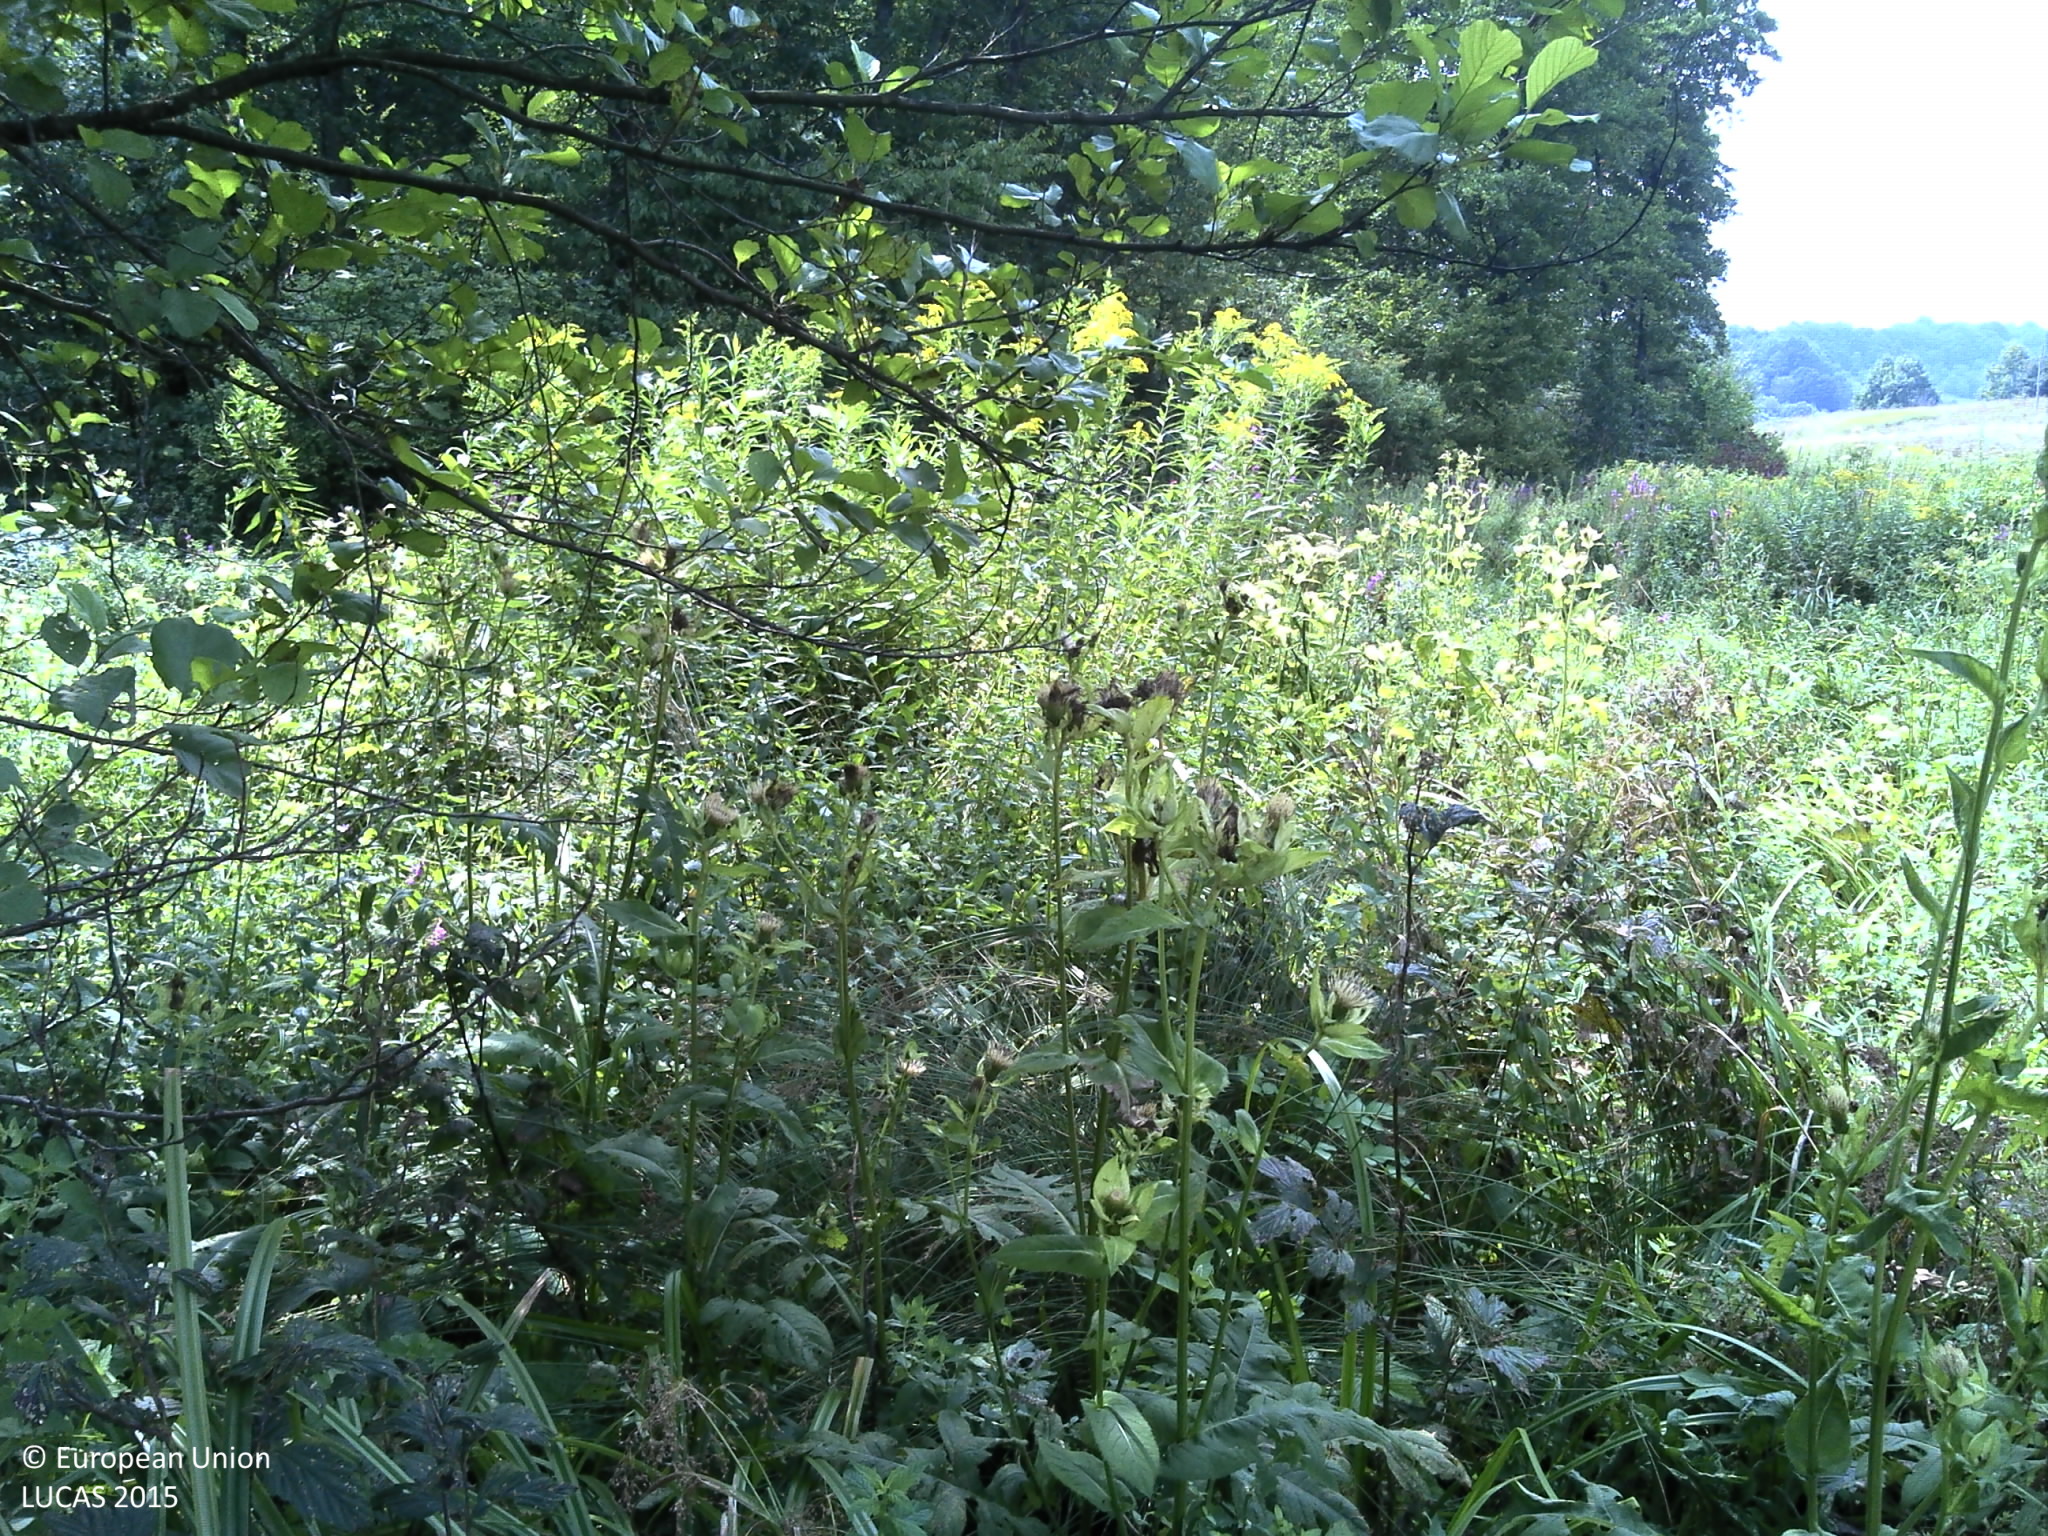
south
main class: Grassland
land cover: Spontaneously vegetated surfaces
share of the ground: > 75 %
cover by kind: herbaceous plants 100 %
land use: Fallow land
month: August
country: HR
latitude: 45.2931
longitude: 16.0788
